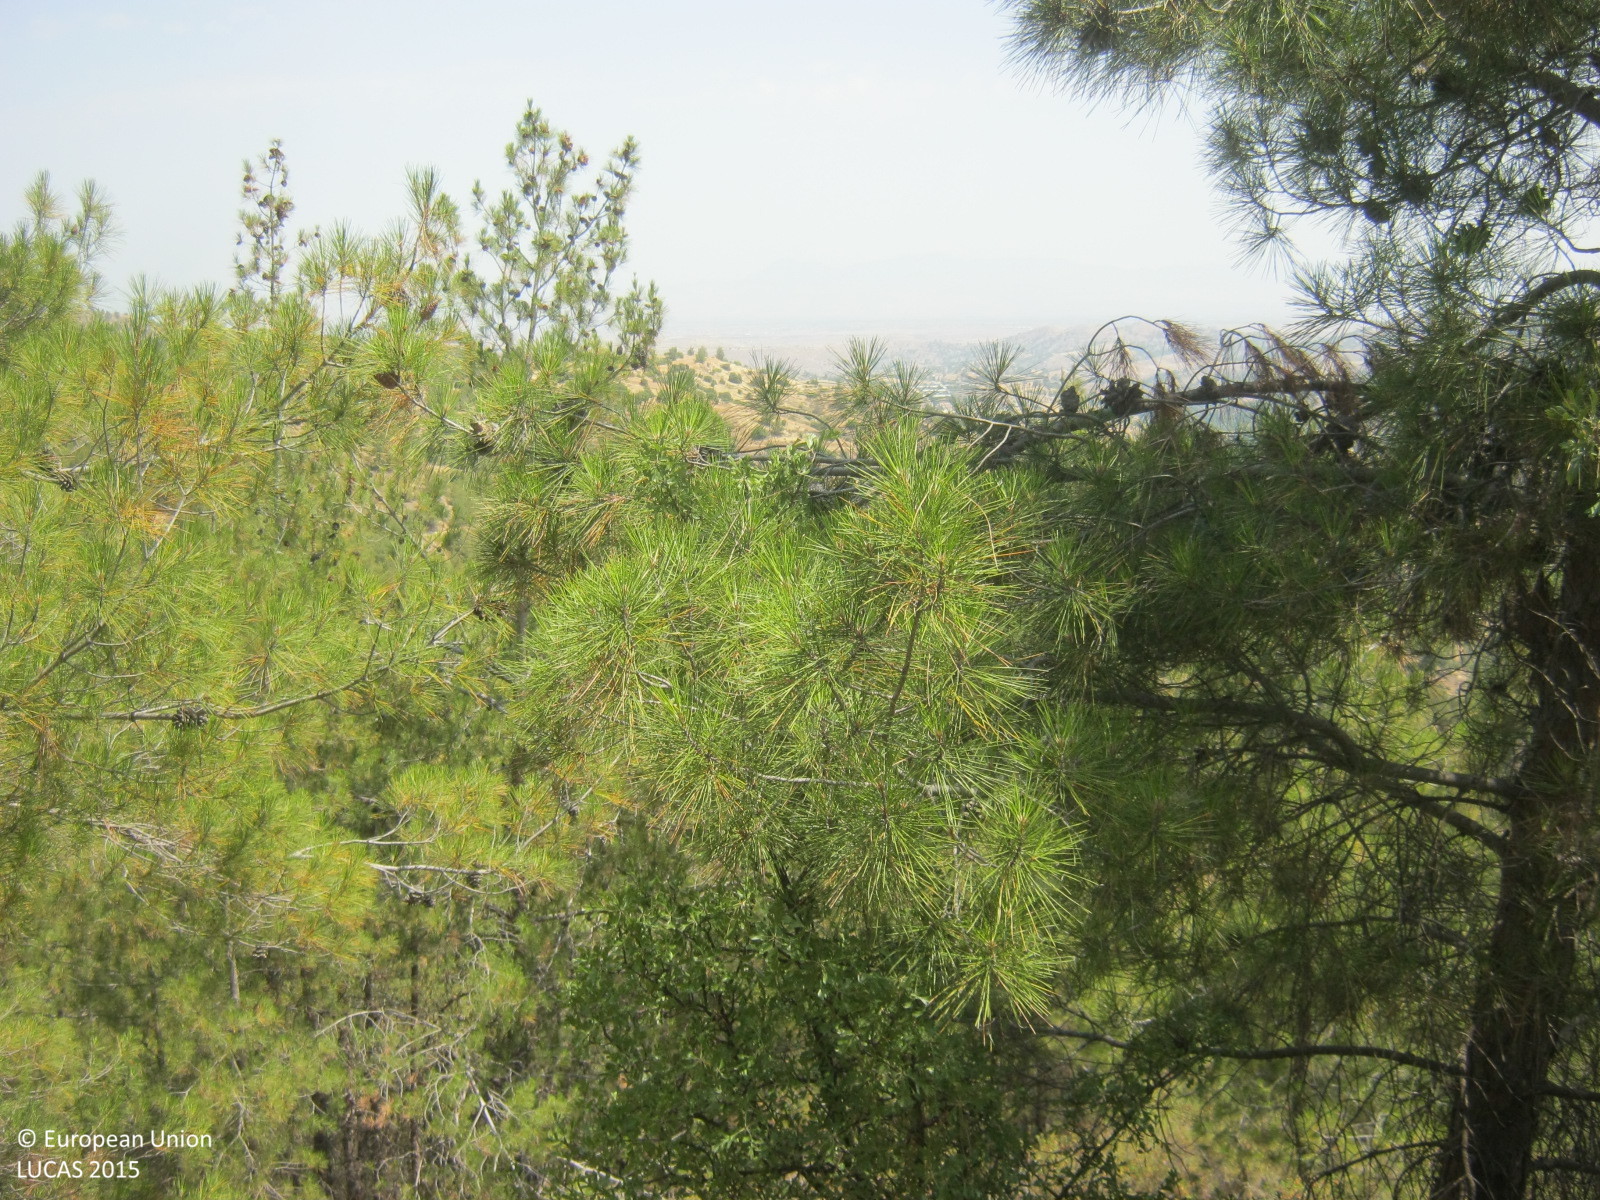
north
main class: Woodland
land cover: Pine dominated coniferous woodland
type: coniferous forest of the mediterranean region
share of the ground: > 75 %
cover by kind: coniferous forest trees 80 %, shrubs 10 %, unconsolidated bare surface 10 %
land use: Forestry
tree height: > 5 m
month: June
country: CY
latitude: 35.0183
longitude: 33.0026
